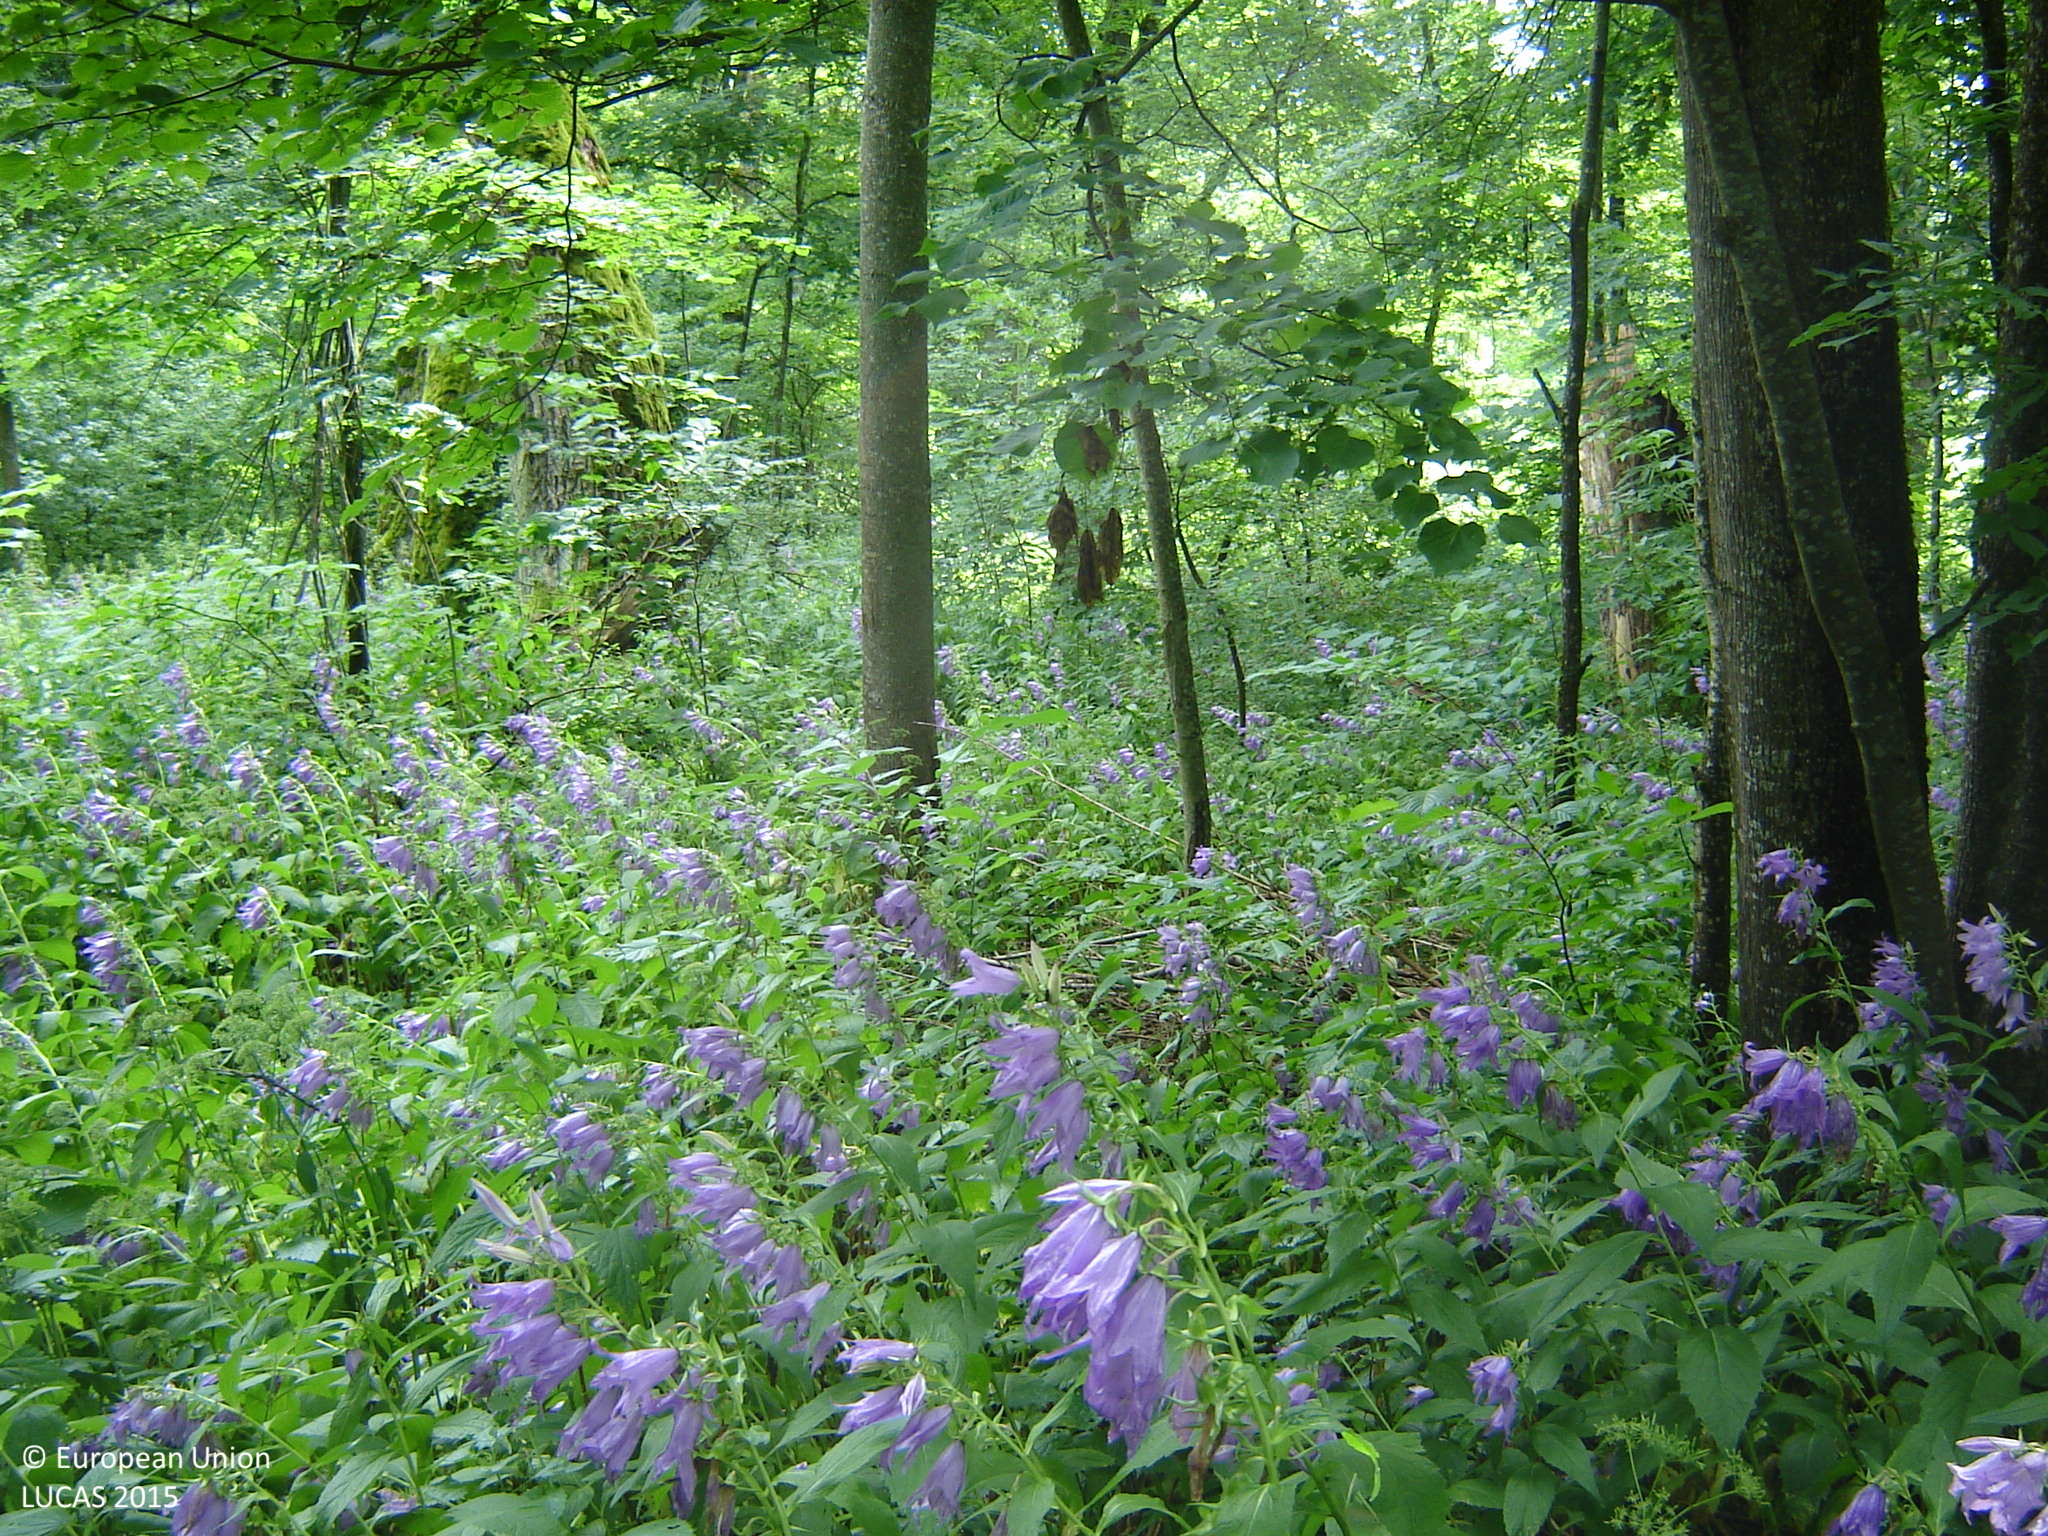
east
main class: Woodland
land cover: Broadleaved woodland
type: floodplain forest
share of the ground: > 75 %
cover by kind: broadleaved forest trees 75 %, herbaceous plants 25 %
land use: Forestry
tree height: > 5 m
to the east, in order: Broadleaved woodland; Inland fresh running water; Broadleaved woodland; Spontaneously vegetated surfaces; Broadleaved woodland; Spontaneously vegetated surfaces; Tracks; Spontaneously vegetated surfaces; Broadleaved woodland; Paved roads, cycling and walking lanes; Broadleaved woodland
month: July
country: LT
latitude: 55.3680
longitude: 25.1847
